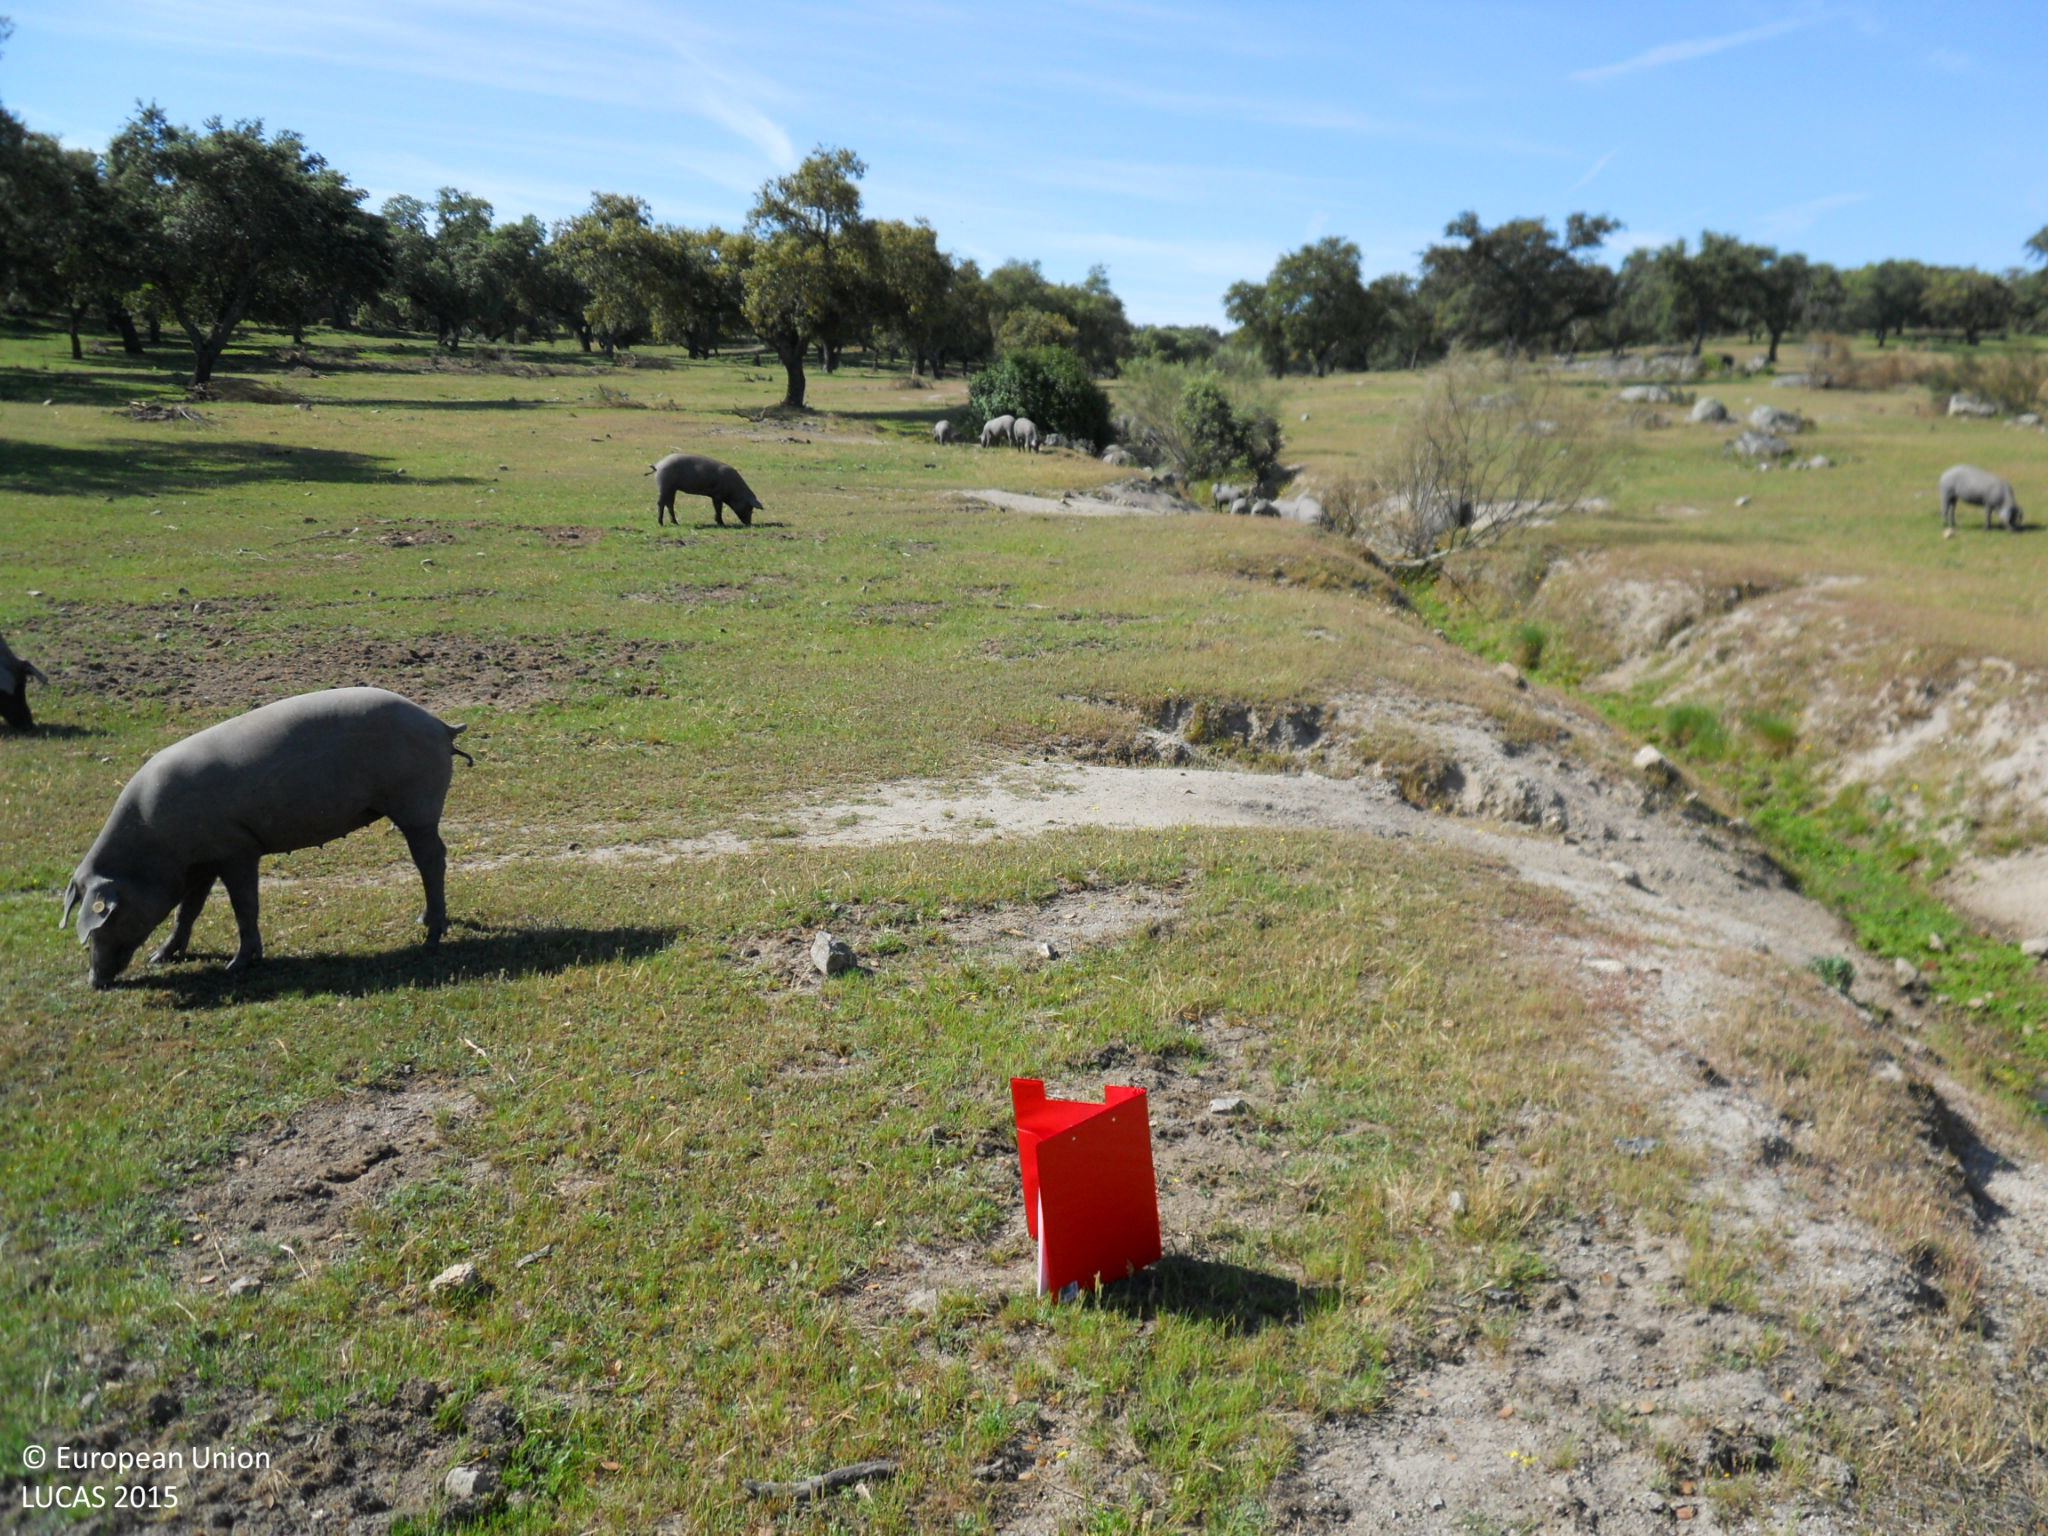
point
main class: Grassland
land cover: Grassland with sparse tree/shrub cover
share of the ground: > 75 %
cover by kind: herbaceous plants 70 %, unconsolidated bare surface 20 %, broadleaved forest trees 5 %, shrubs 5 %
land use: Agriculture (excluding fallow land and kitchen gardens)
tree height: > 5 m
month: April
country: ES
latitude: 39.3202
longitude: -7.0254
